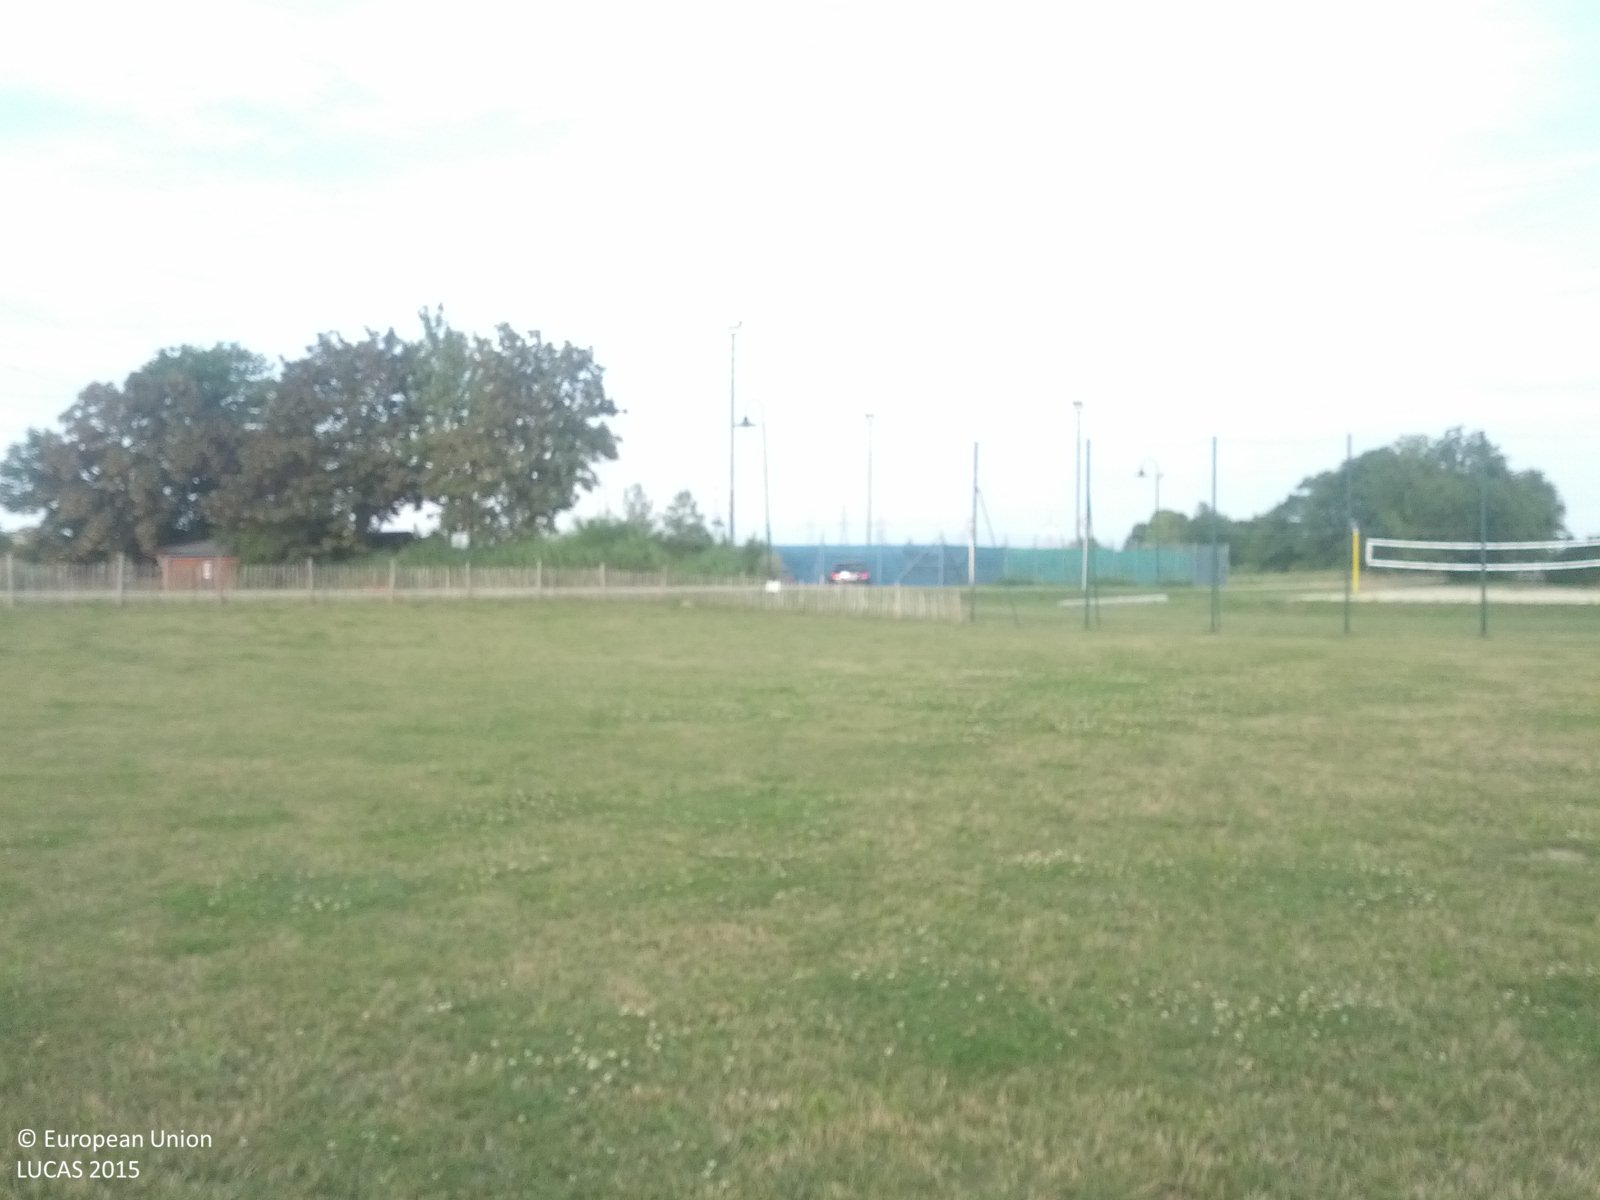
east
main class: Grassland
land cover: Grassland without tree/shrub cover
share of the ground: > 75 %
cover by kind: herbaceous plants 95 %, unconsolidated bare surface 5 %
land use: Sport
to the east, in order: Grassland without tree/shrub cover; Fences; Grassland without tree/shrub cover; Artificial constructions in urban areas; Other bare soil; Other fibre and oleaginous crops; Other fresh vegetables; Grass margins; Common wheat; Other bare soil; Fences; Vineyards
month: July
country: AT
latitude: 48.3584
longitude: 16.4703
